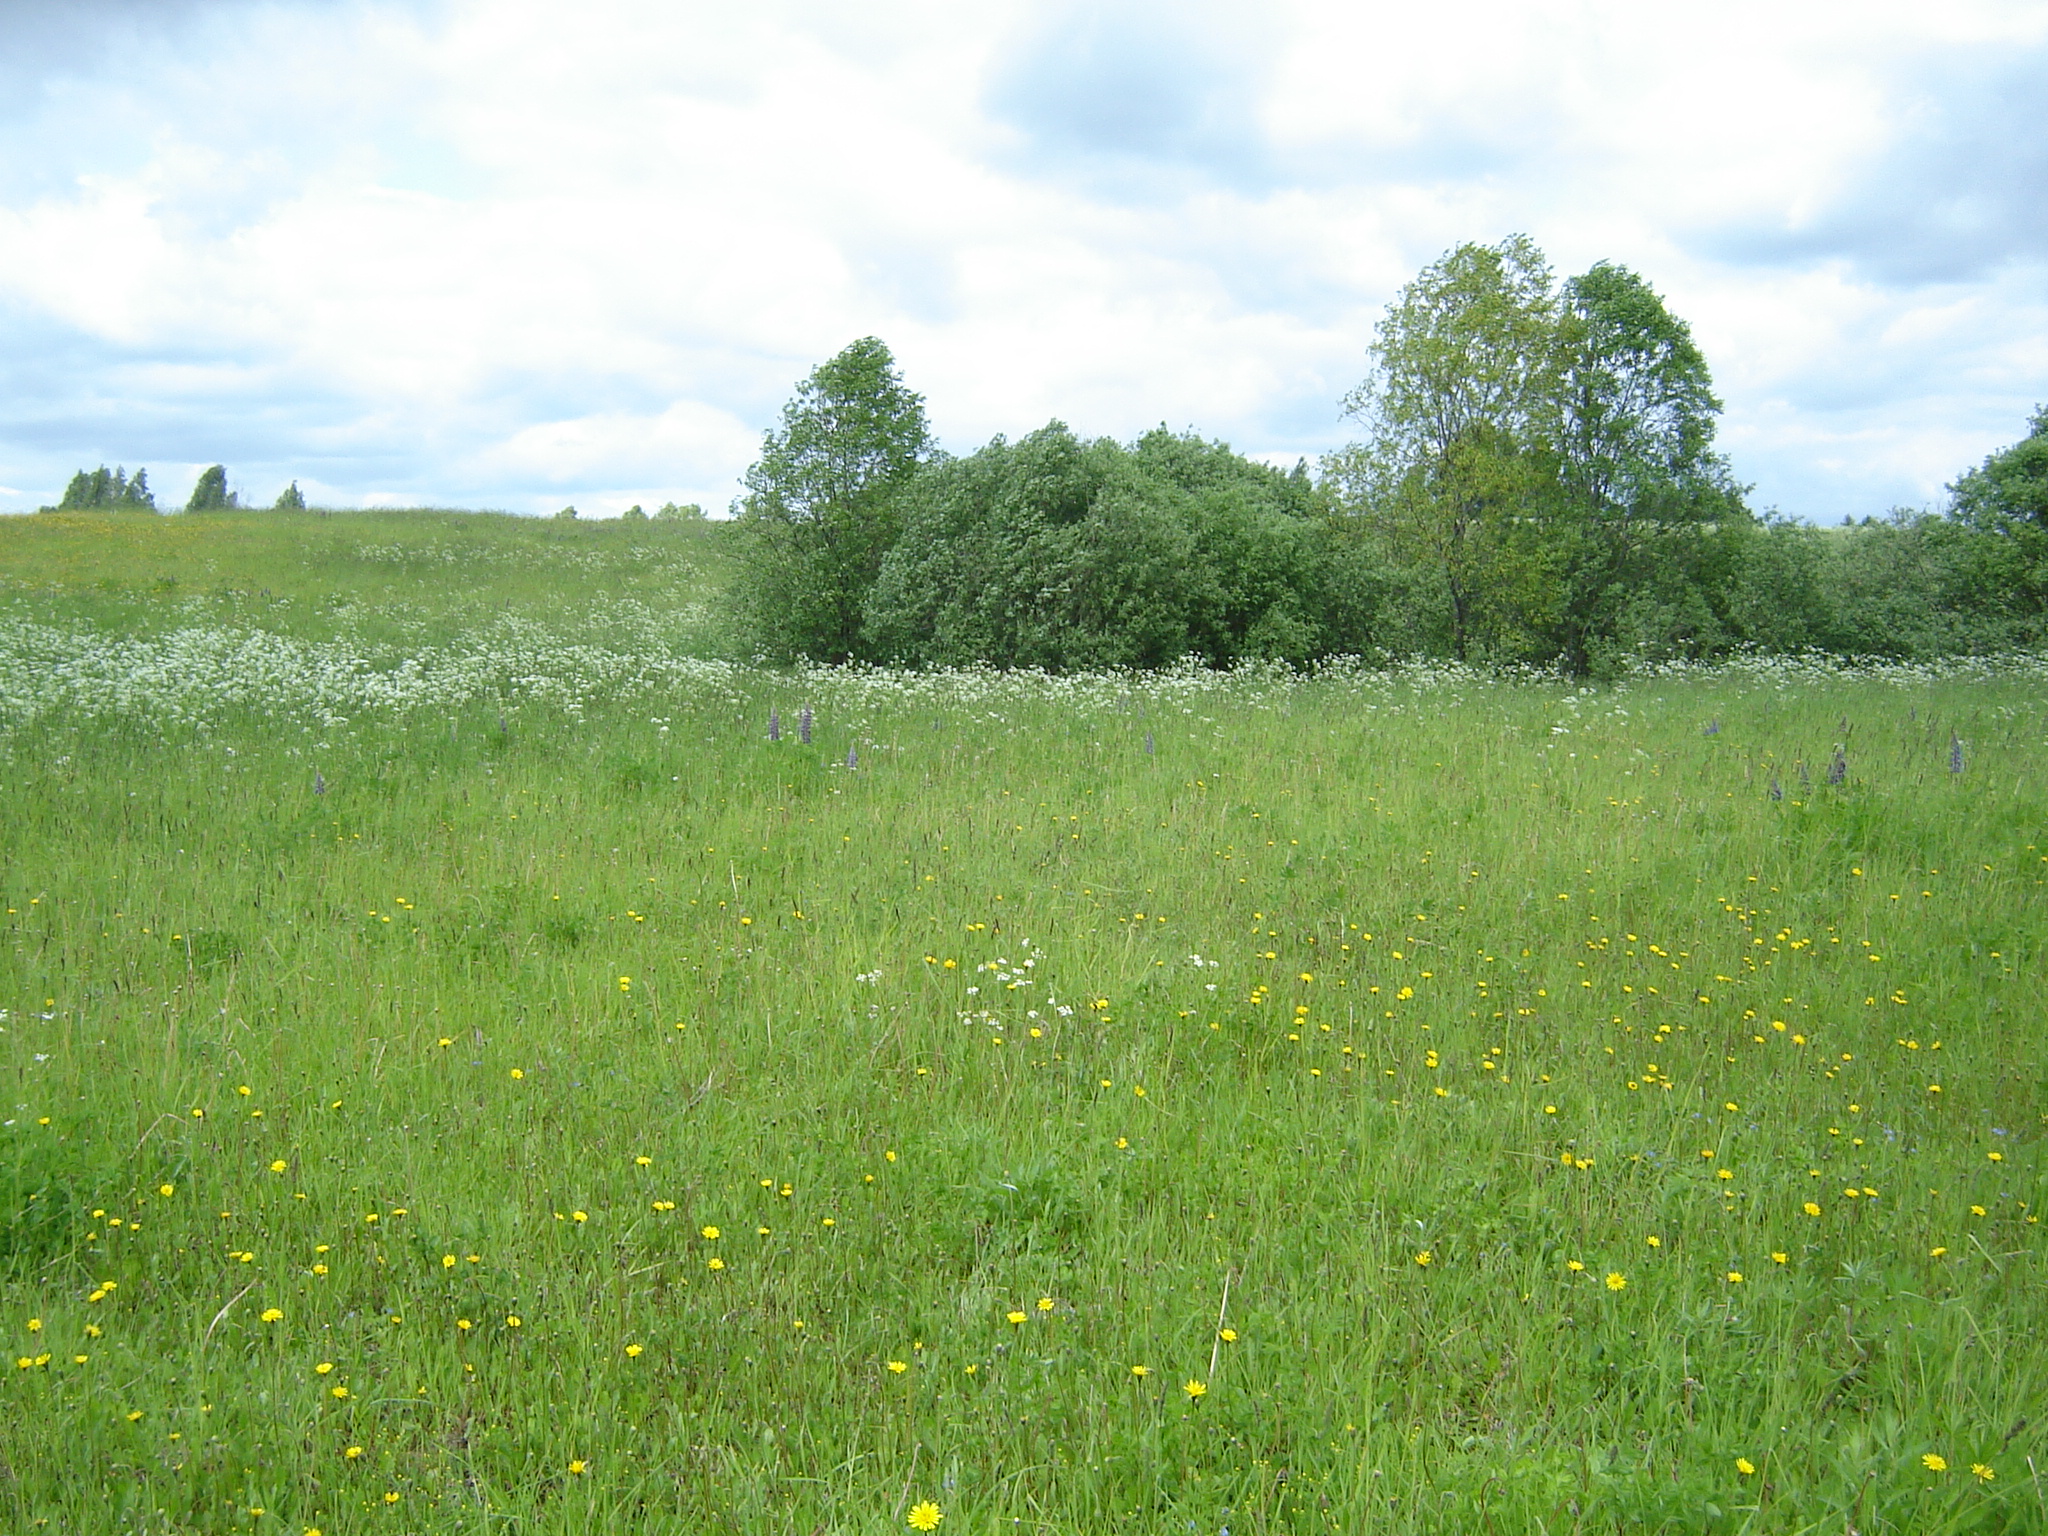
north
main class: Grassland
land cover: Grassland without tree/shrub cover
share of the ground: > 75 %
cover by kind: herbaceous plants 100 %
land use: Agriculture (excluding fallow land and kitchen gardens)
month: June
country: LT
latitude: 55.7049
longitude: 25.5777
